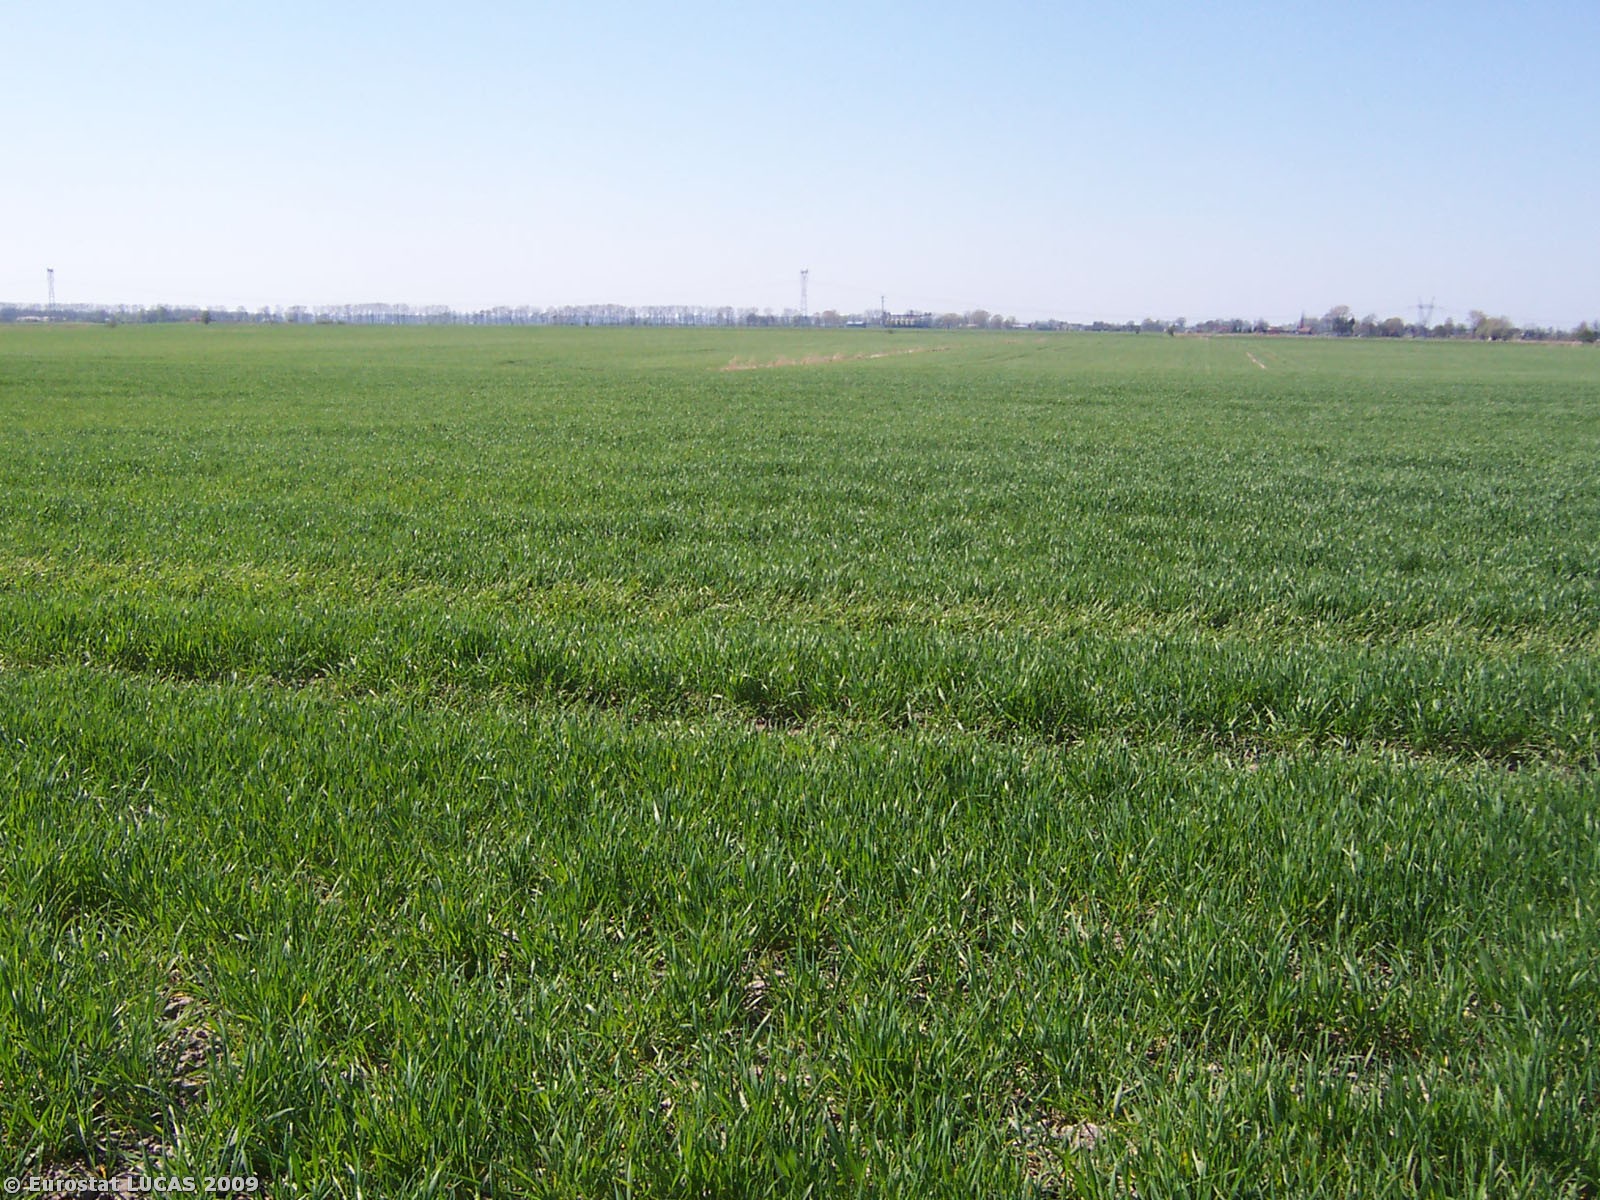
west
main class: Cropland
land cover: Common wheat
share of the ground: 25 - 50 %
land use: Agriculture (excluding fallow land and kitchen gardens)
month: April
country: PL
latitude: 54.0644
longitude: 18.9595
